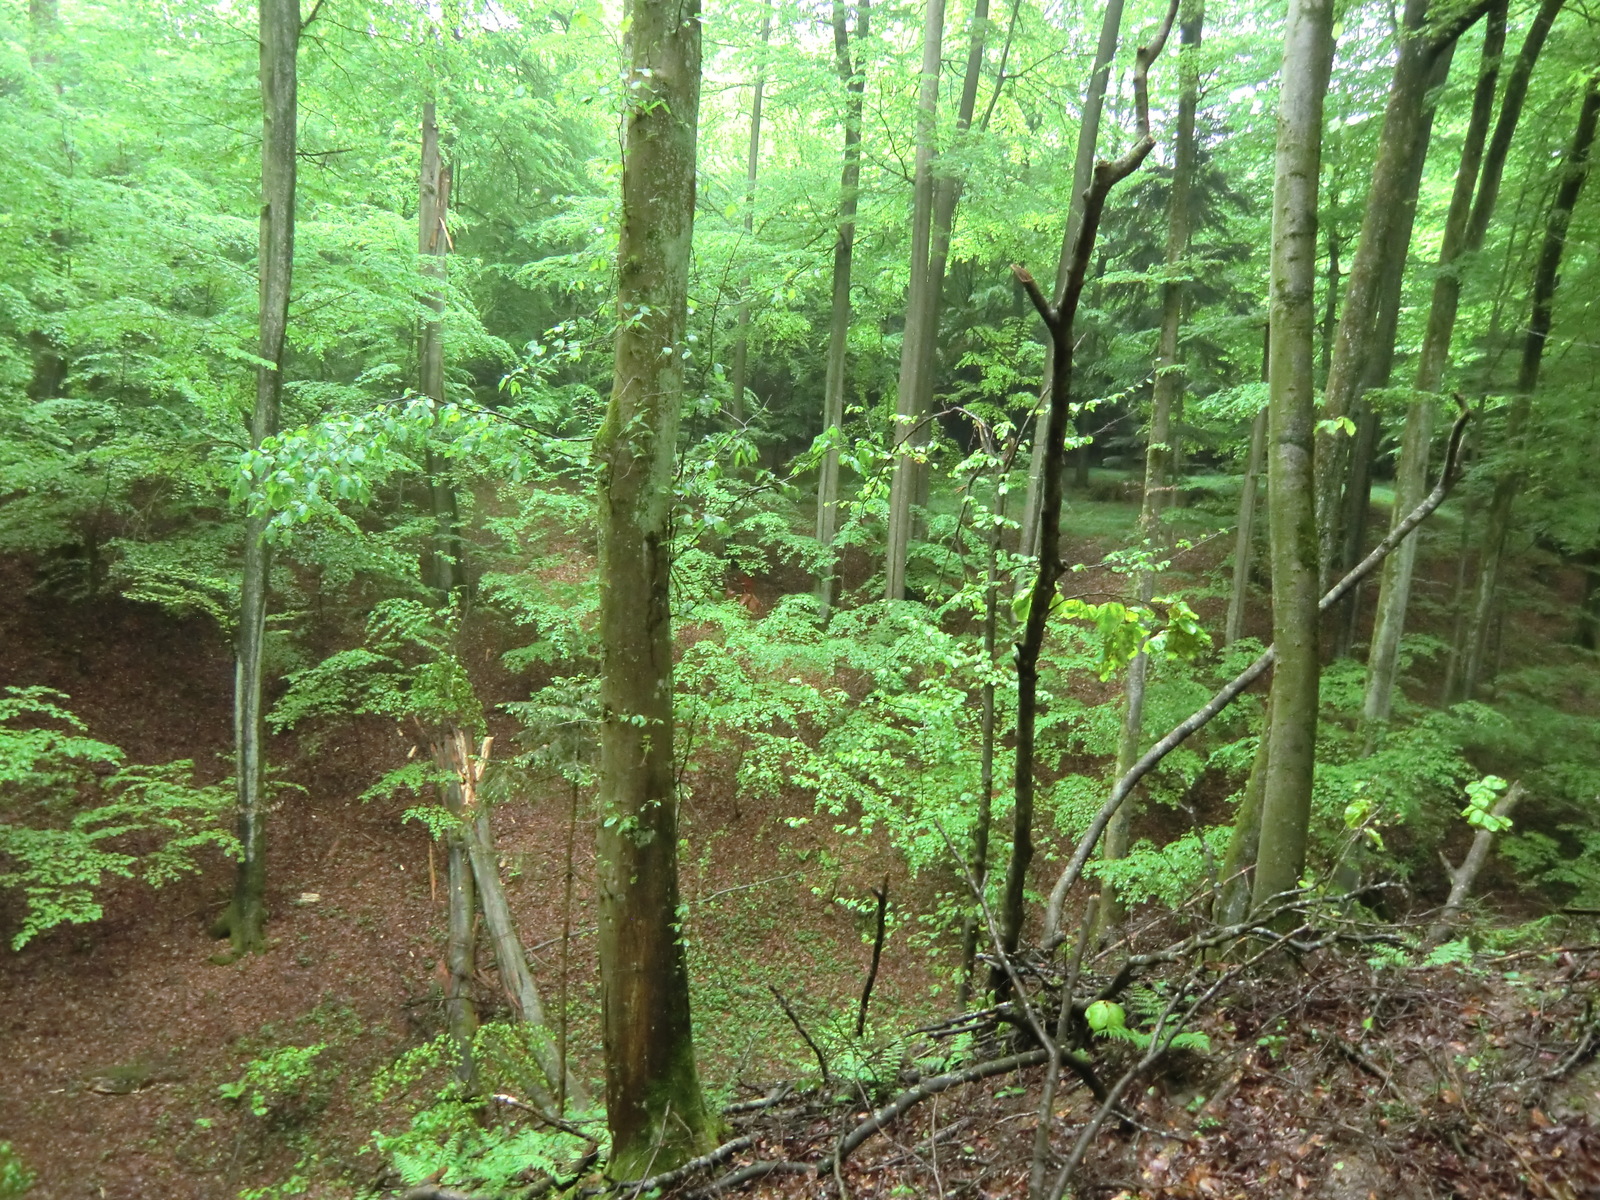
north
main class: Woodland
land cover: Broadleaved woodland
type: beech forest
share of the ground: > 75 %
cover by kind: broadleaved forest trees 80 %, unconsolidated bare surface 15 %, herbaceous plants 5 %
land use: Forestry
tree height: > 5 m
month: May
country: AT
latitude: 48.2292
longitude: 14.7529
